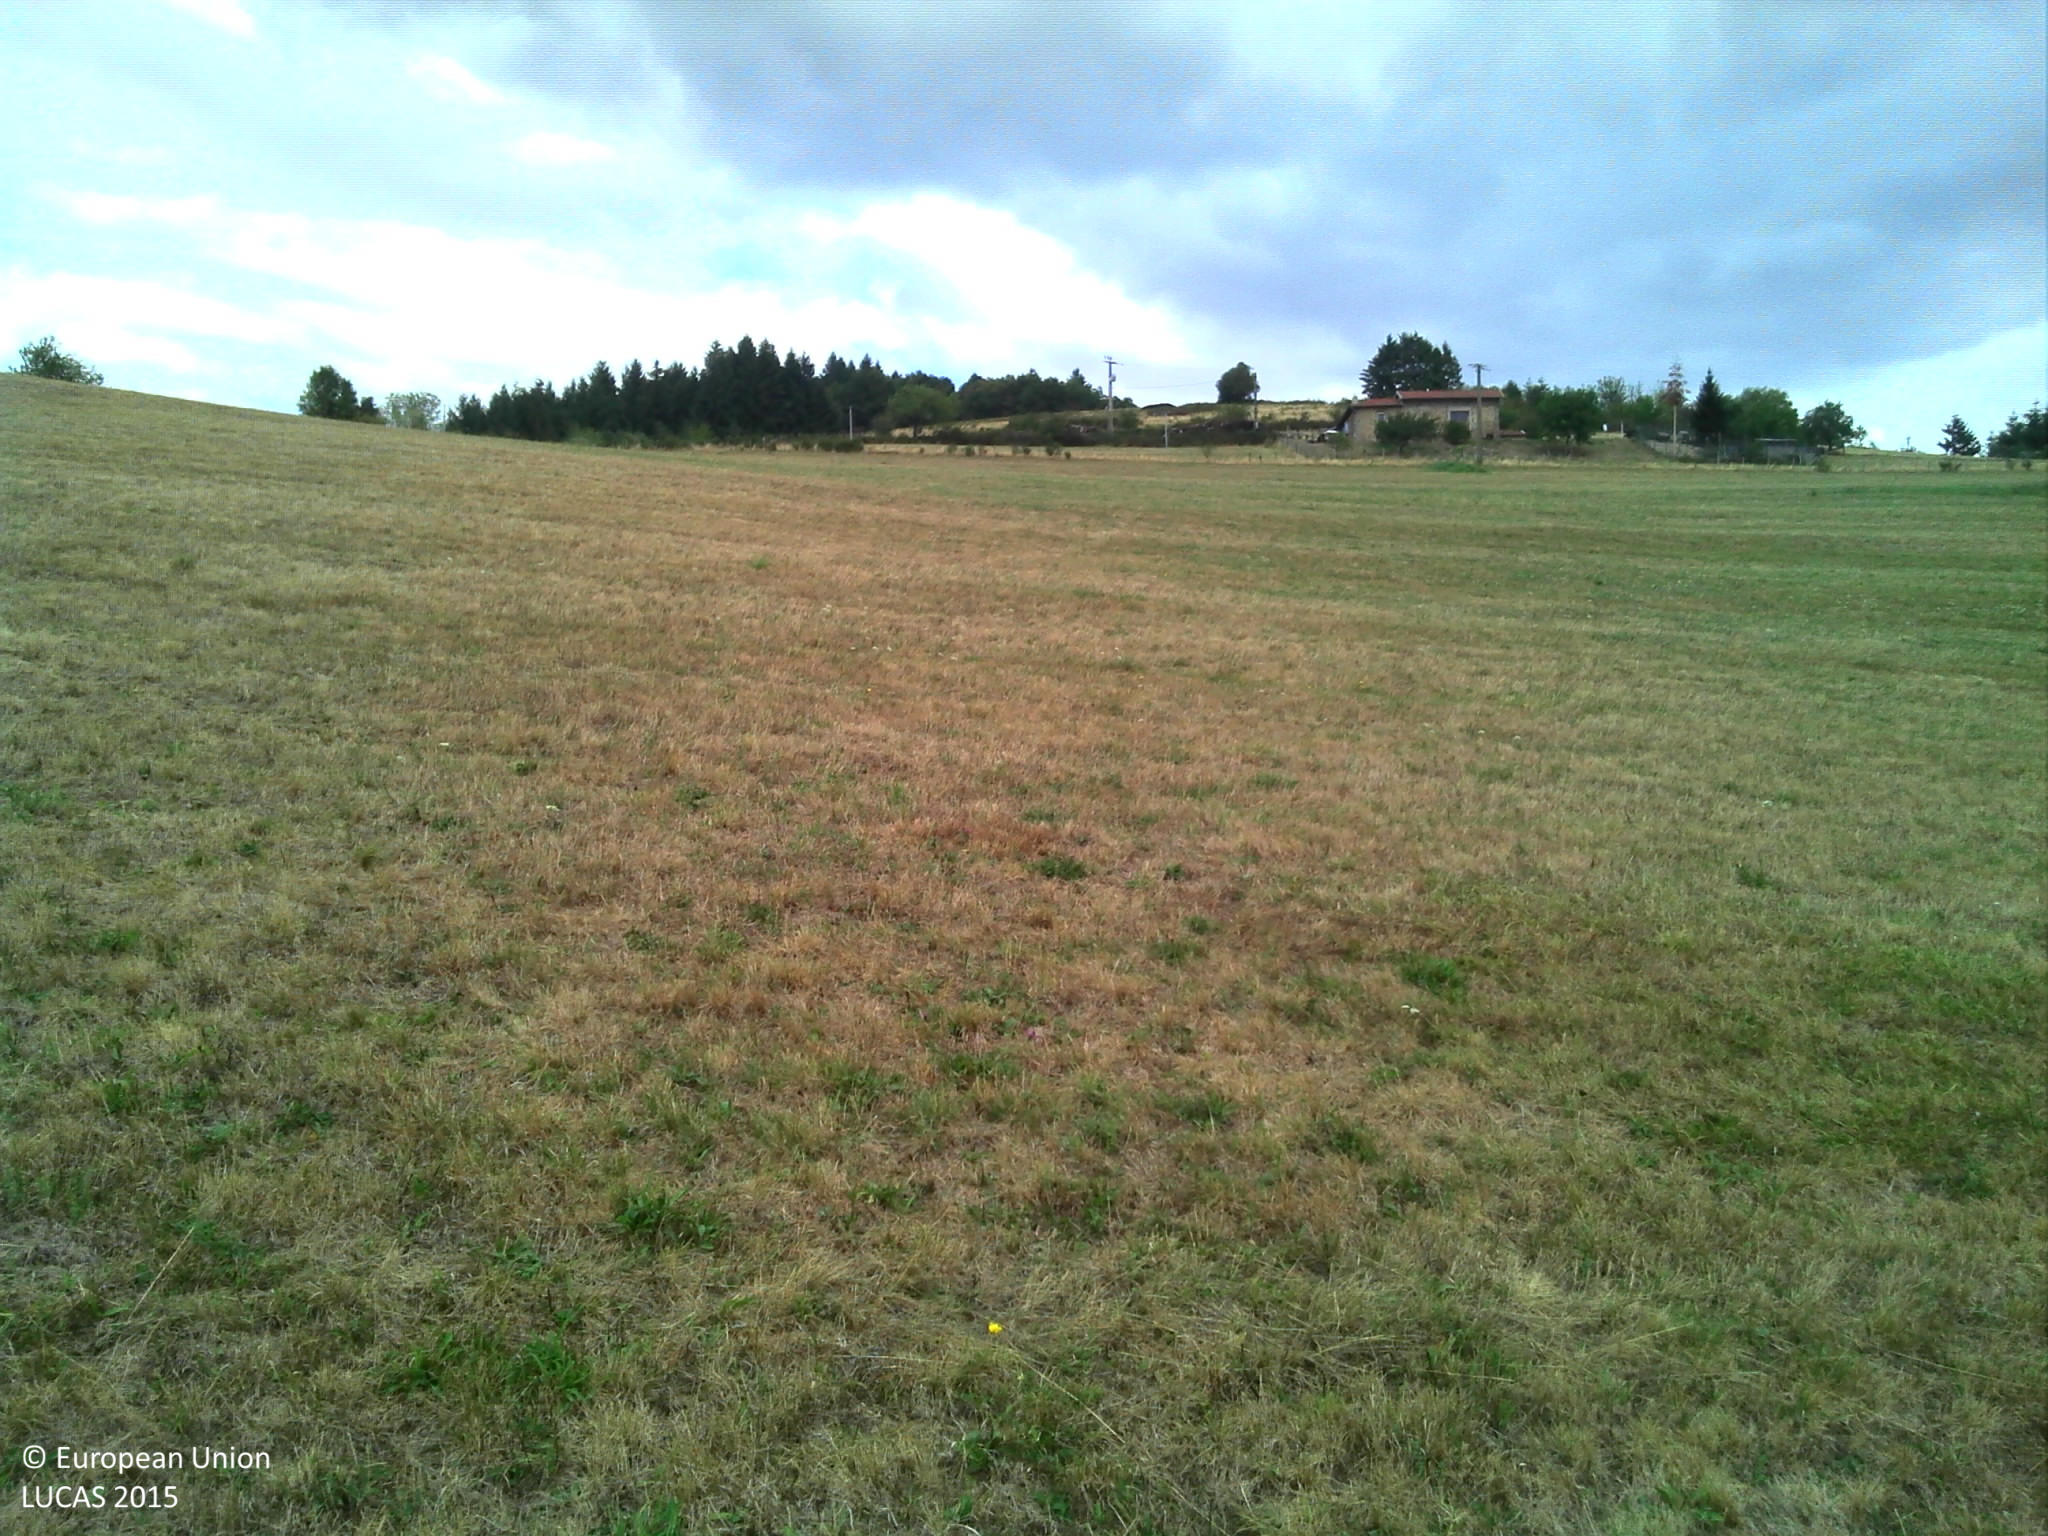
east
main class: Grassland
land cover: Grassland without tree/shrub cover
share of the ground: > 75 %
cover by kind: herbaceous plants 100 %
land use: Agriculture (excluding fallow land and kitchen gardens)
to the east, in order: Grassland without tree/shrub cover; Fences; Grassland without tree/shrub cover; Electric lines; Grassland without tree/shrub cover; Abandoned hedges; Electric lines; Other structural elements; Grass margins; Paved roads, cycling and walking lanes; Grass margins; Dry stone walls; Managed hedges; Fences; Grassland without tree/shrub cover
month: August
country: FR
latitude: 46.0657
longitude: 4.5081
